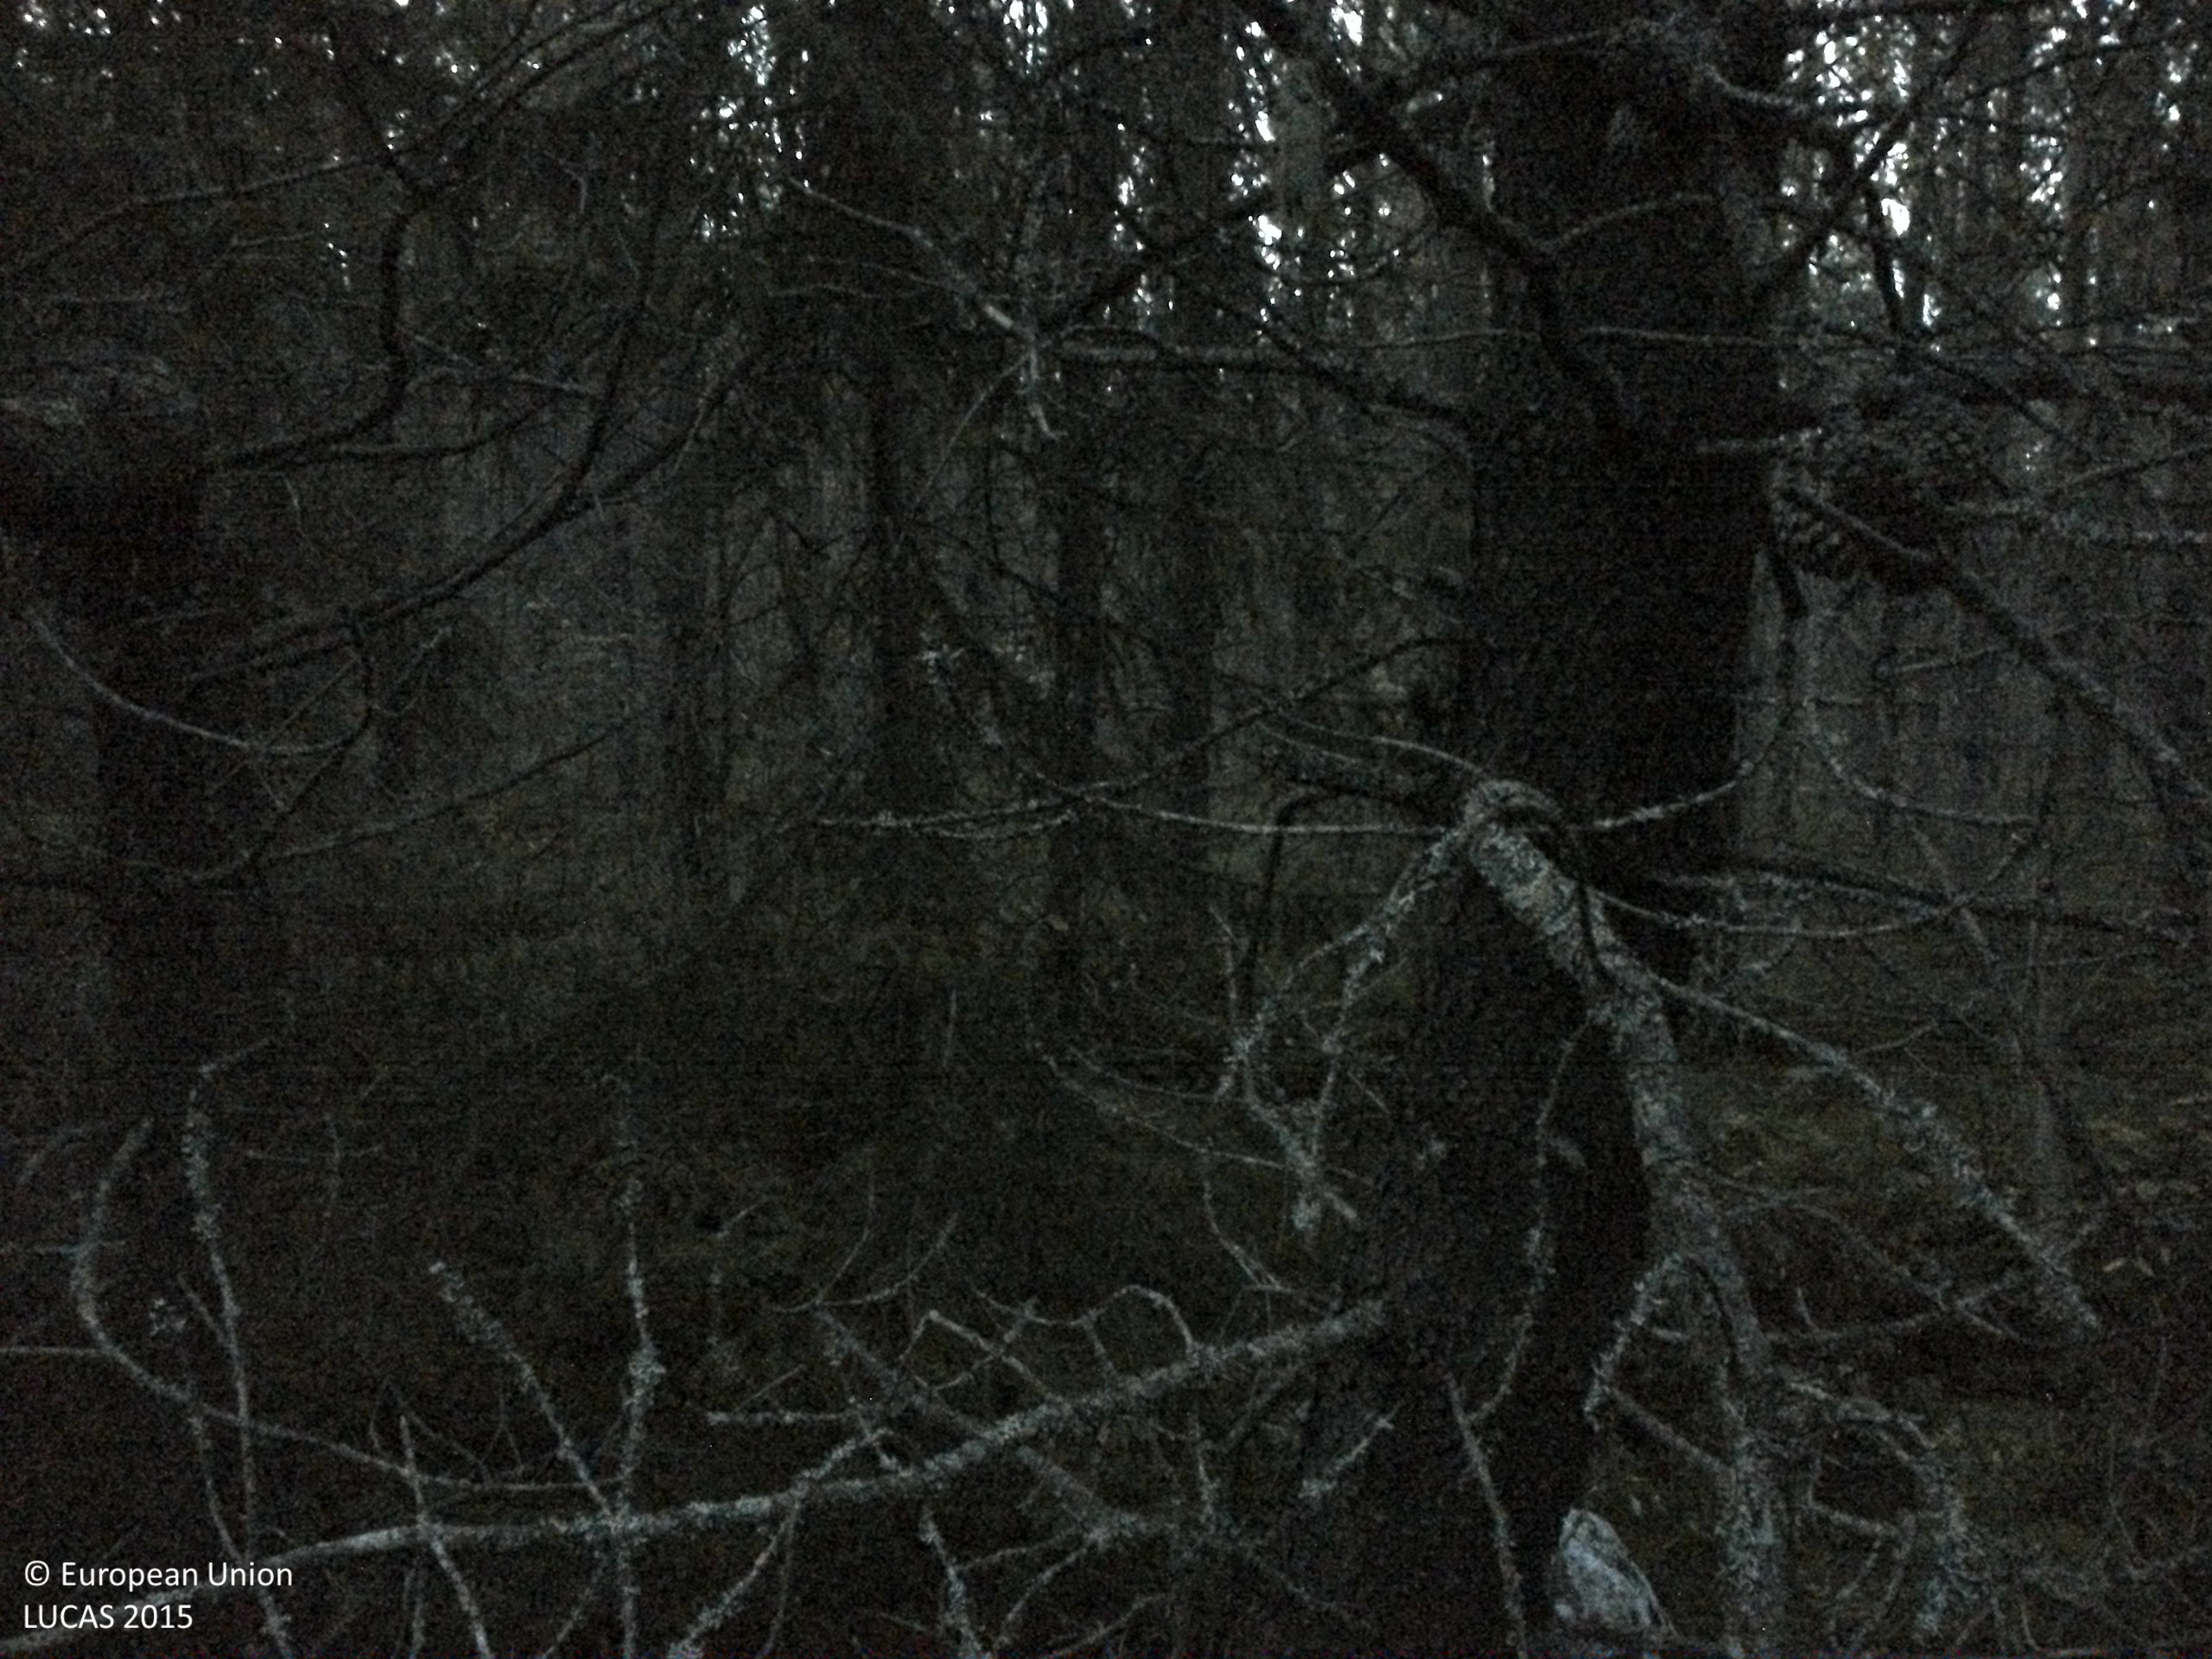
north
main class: Woodland
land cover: Pine dominated coniferous woodland
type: exotic forest
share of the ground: > 75 %
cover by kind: coniferous forest trees 70 %, broadleaved forest trees 10 %, shrubs 10 %, lichens and mosses 10 %
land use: Forestry
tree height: > 5 m
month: September
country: SE
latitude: 63.9149
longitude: 16.6368
